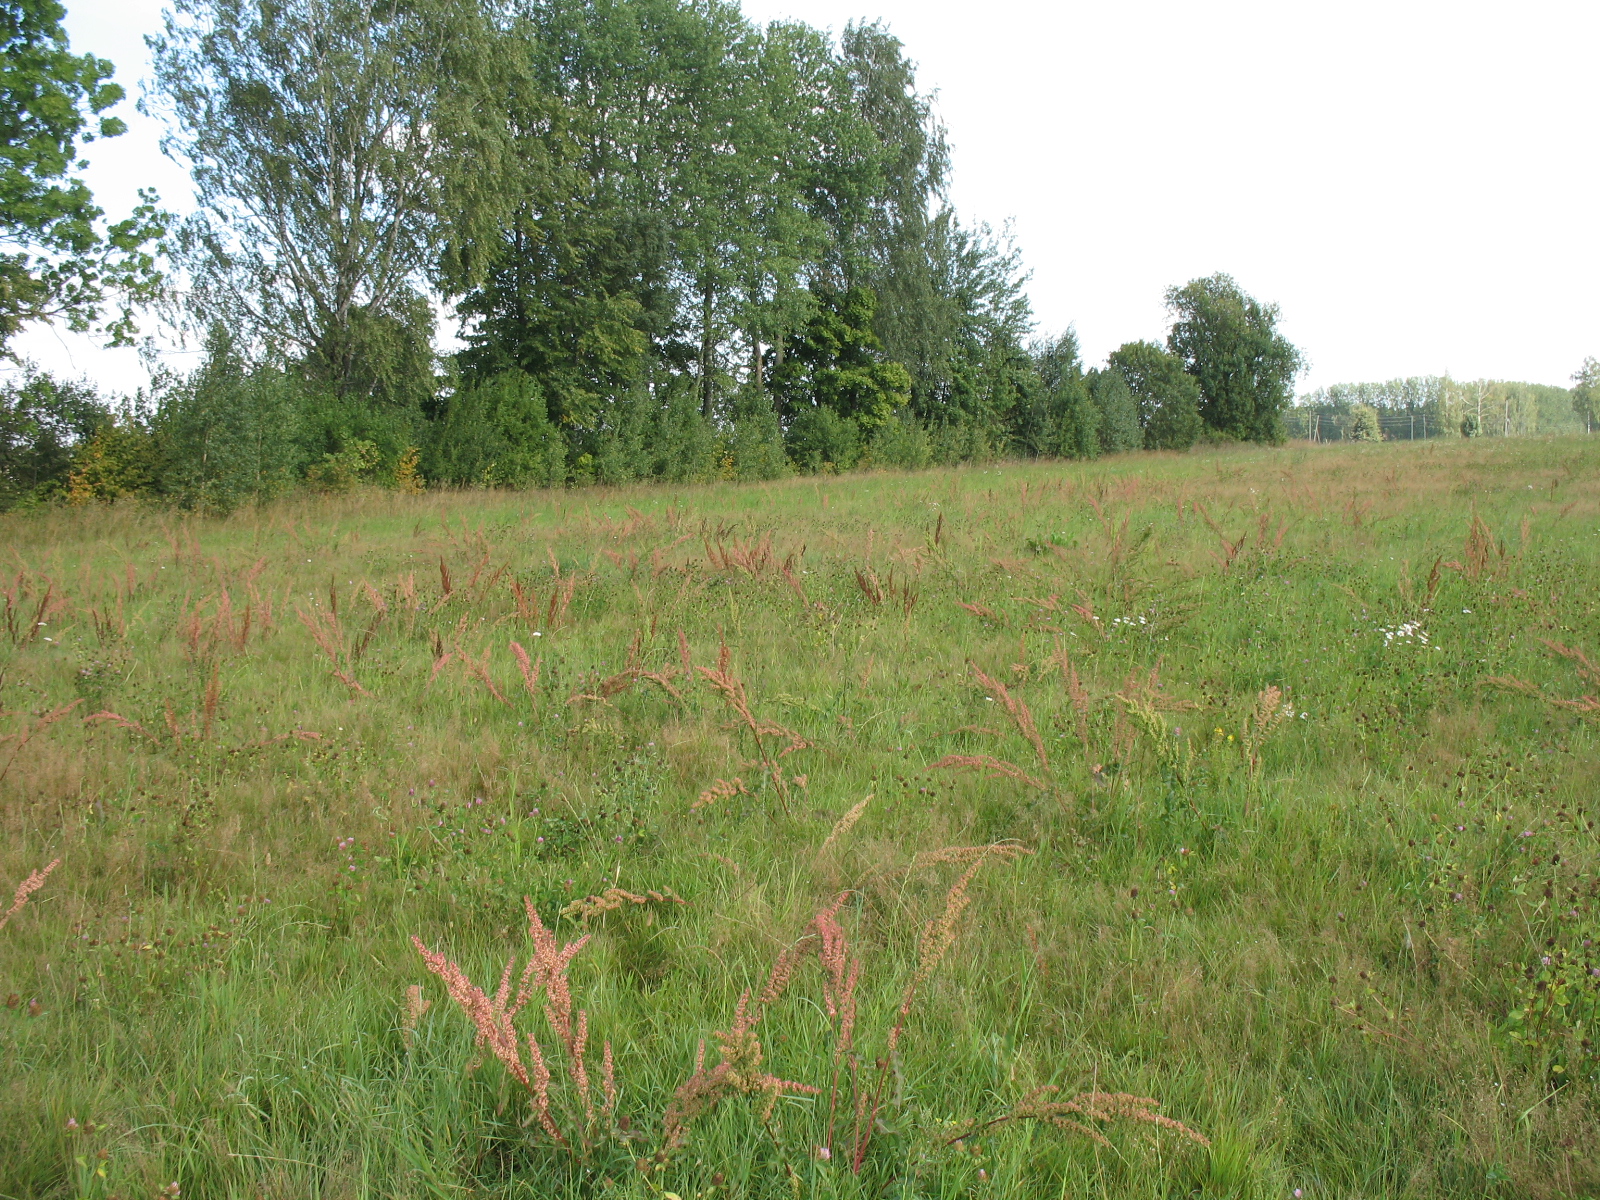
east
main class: Grassland
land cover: Grassland without tree/shrub cover
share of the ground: > 75 %
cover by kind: herbaceous plants 100 %
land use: Agriculture (excluding fallow land and kitchen gardens)
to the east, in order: Grassland without tree/shrub cover; Broadleaved woodland; Grassland without tree/shrub cover; Other bare soil; Grass margins; Paved roads, cycling and walking lanes; Grassland without tree/shrub cover; Common wheat; Electric lines; Common wheat
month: August
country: LV
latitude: 56.2968
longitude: 25.9860
